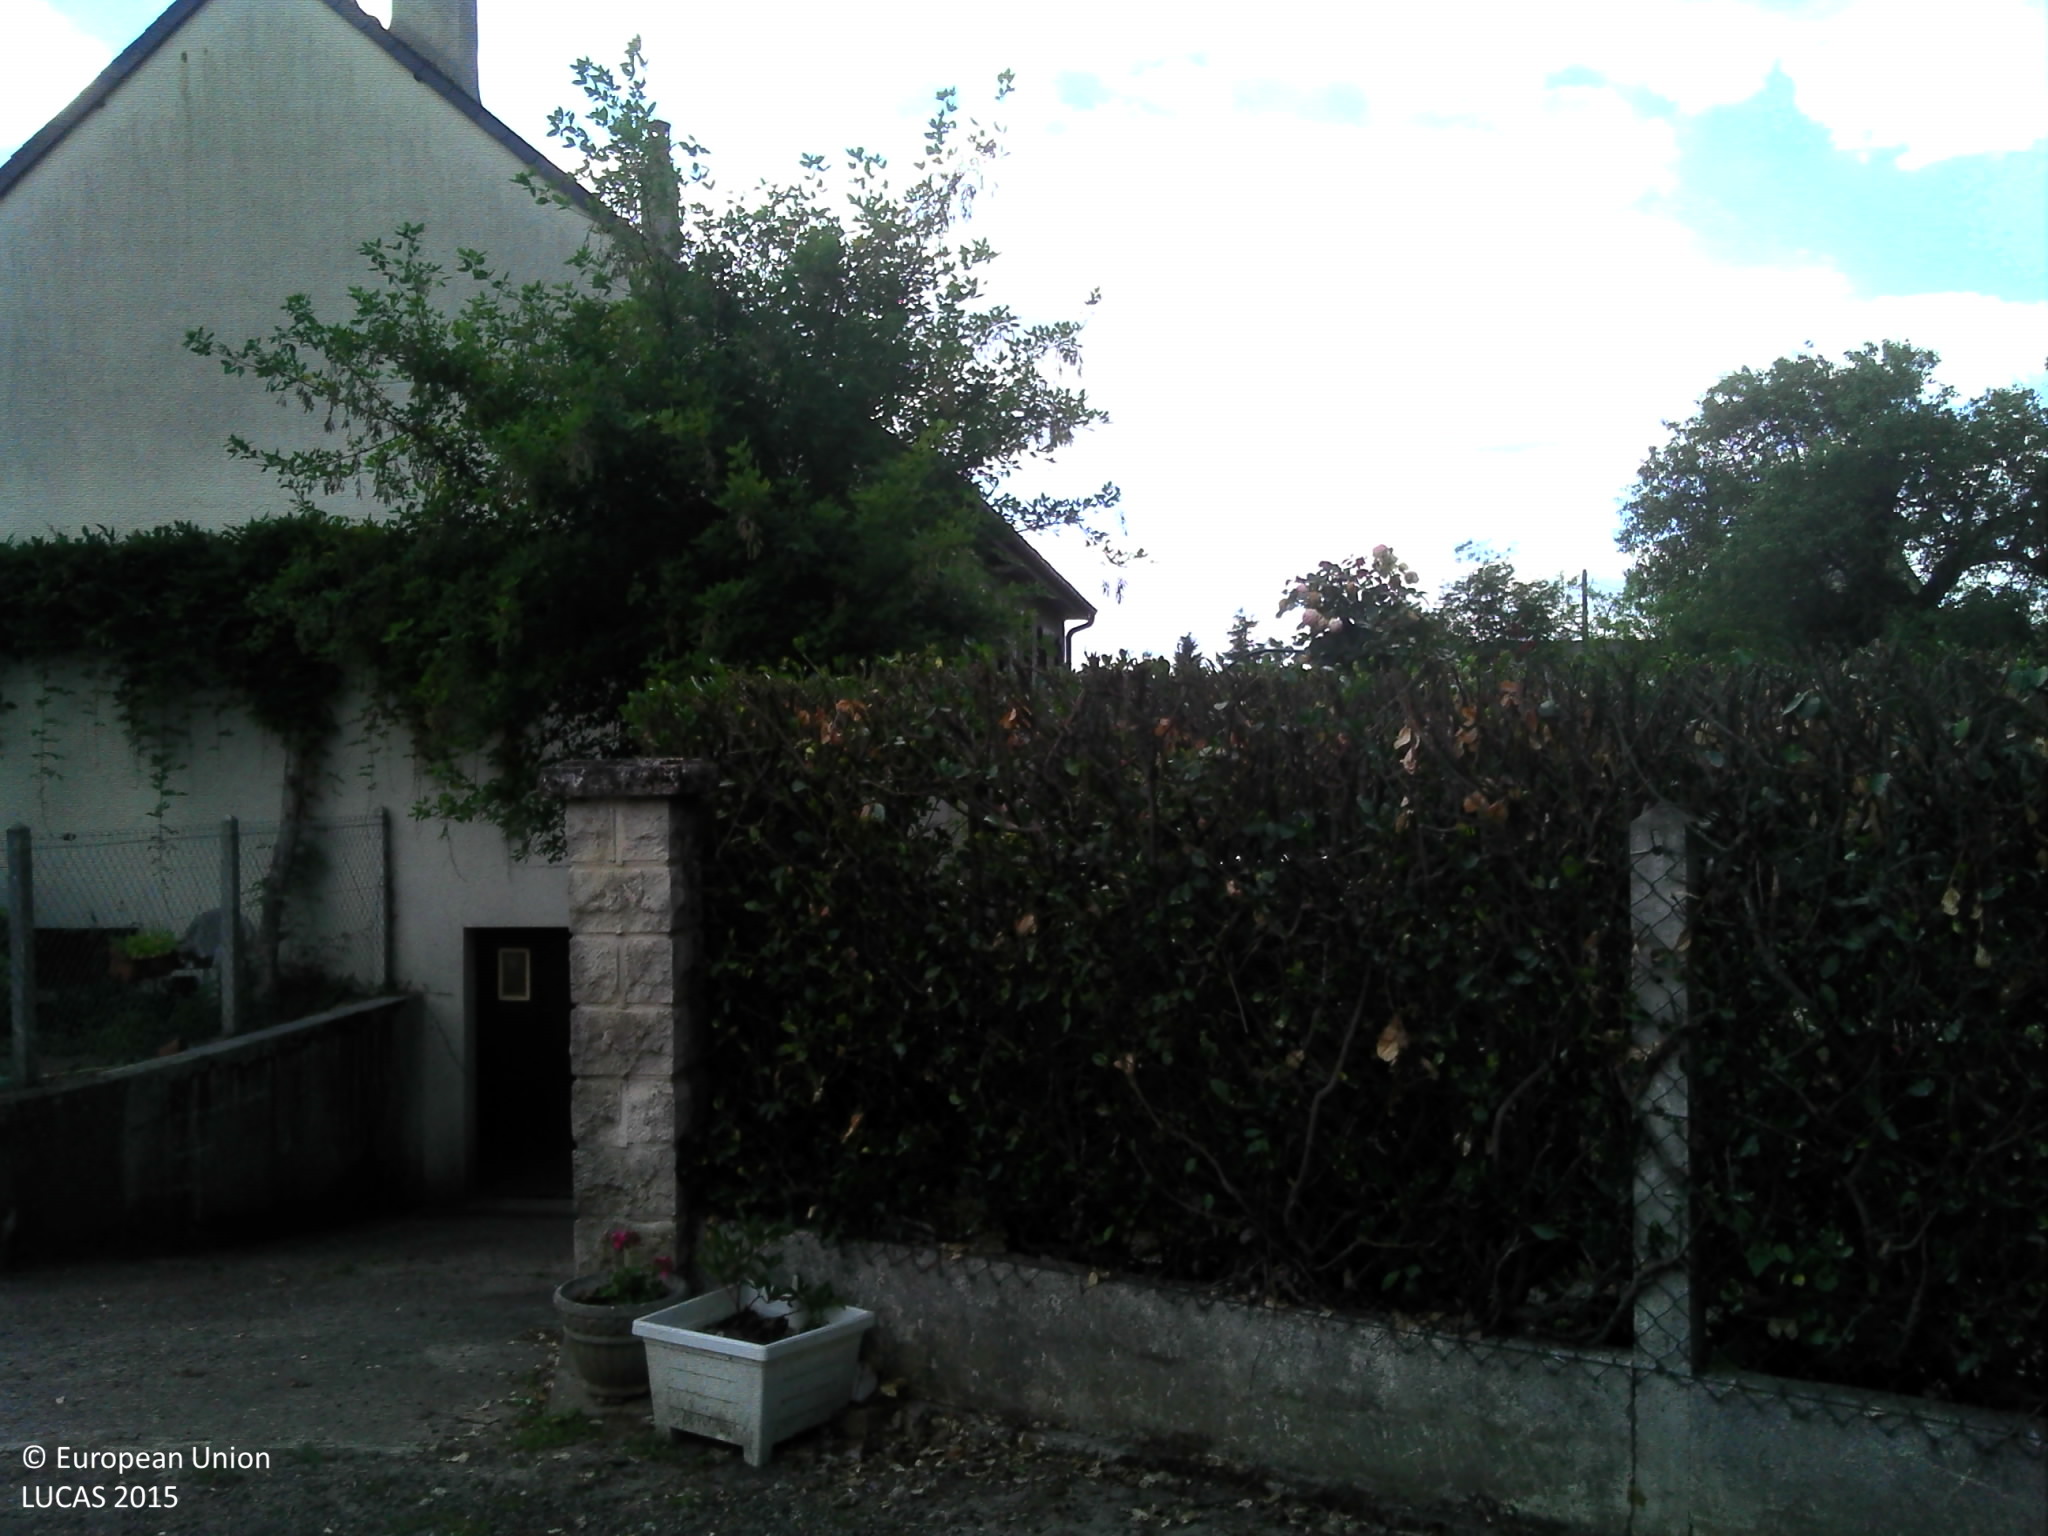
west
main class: Woodland
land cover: Pine dominated mixed woodland
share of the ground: > 75 %
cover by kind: coniferous forest trees 40 %, herbaceous plants 35 %, broadleaved forest trees 25 %
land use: Residential
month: June
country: FR
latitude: 47.3074
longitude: 0.7355
